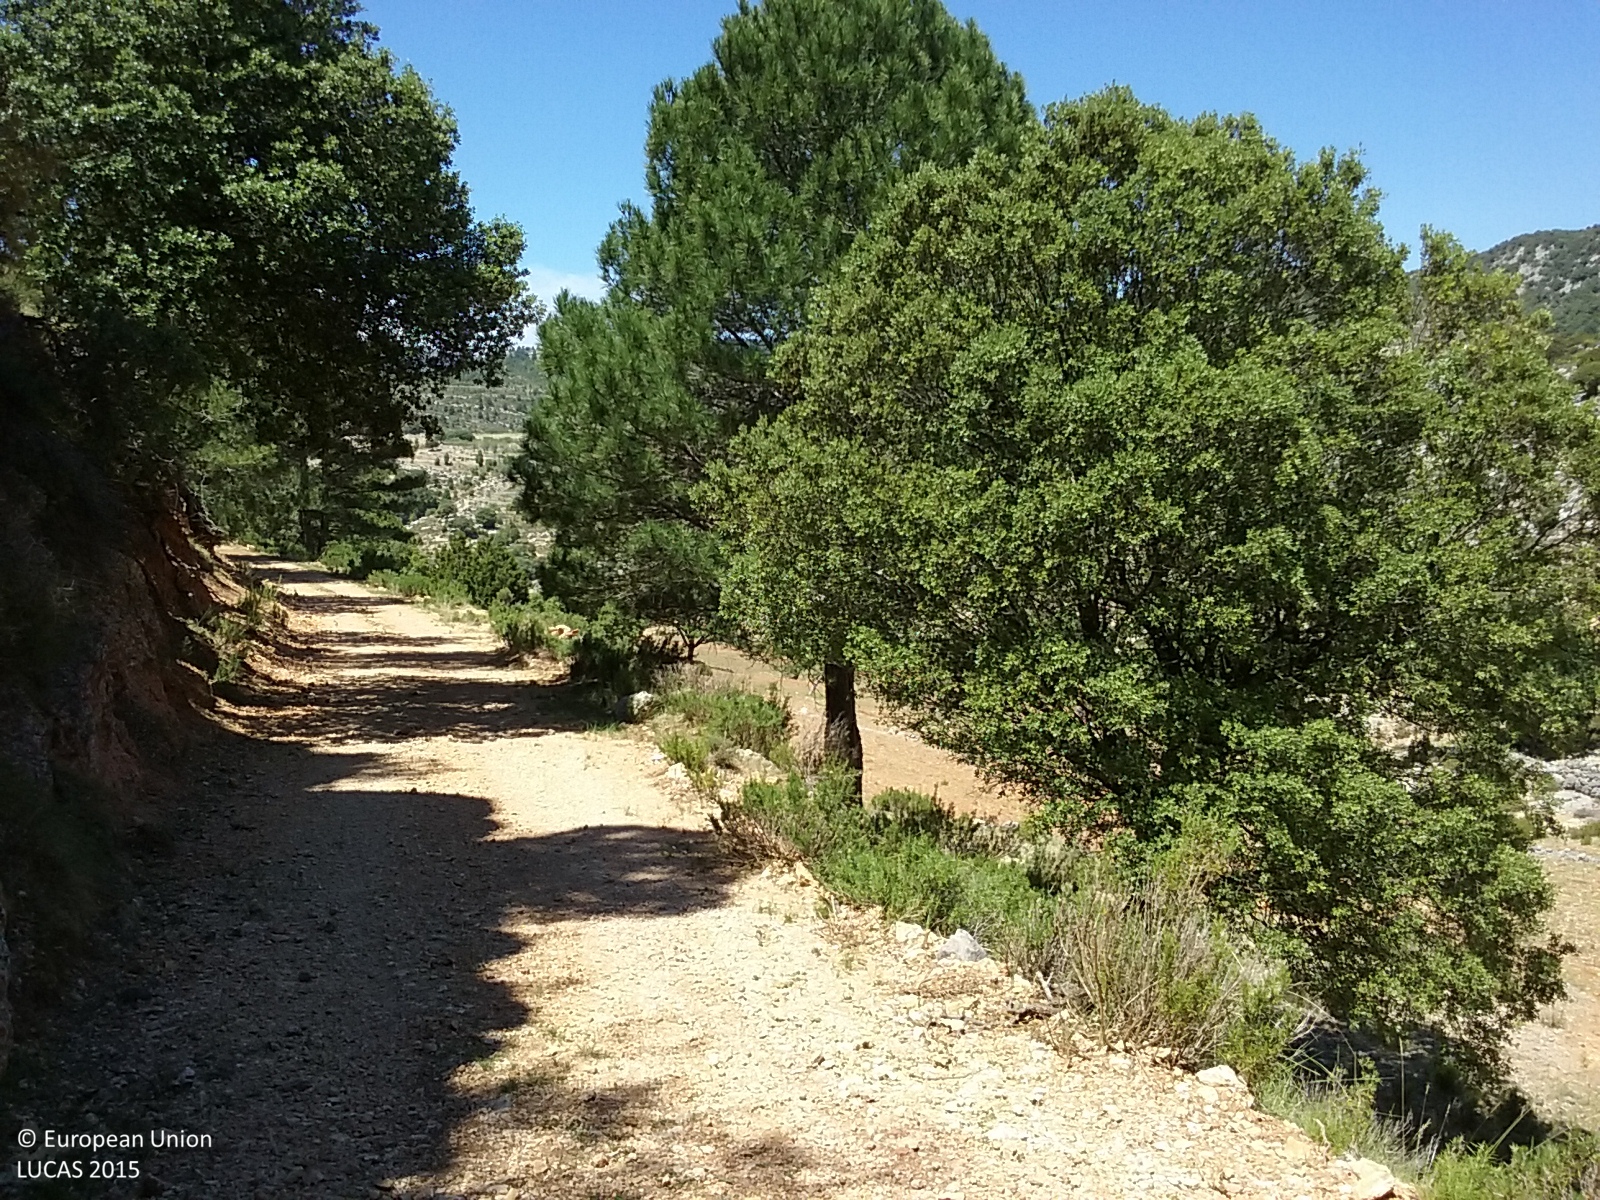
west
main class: Woodland
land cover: Pine dominated mixed woodland
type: coniferous forest of the mediterranean region
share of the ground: > 75 %
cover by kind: coniferous forest trees 40 %, broadleaved forest trees 40 %, shrubs 10 %, unconsolidated bare surface 10 %
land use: Forestry
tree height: > 5 m
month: June
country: ES
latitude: 40.6166
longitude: 0.0526
